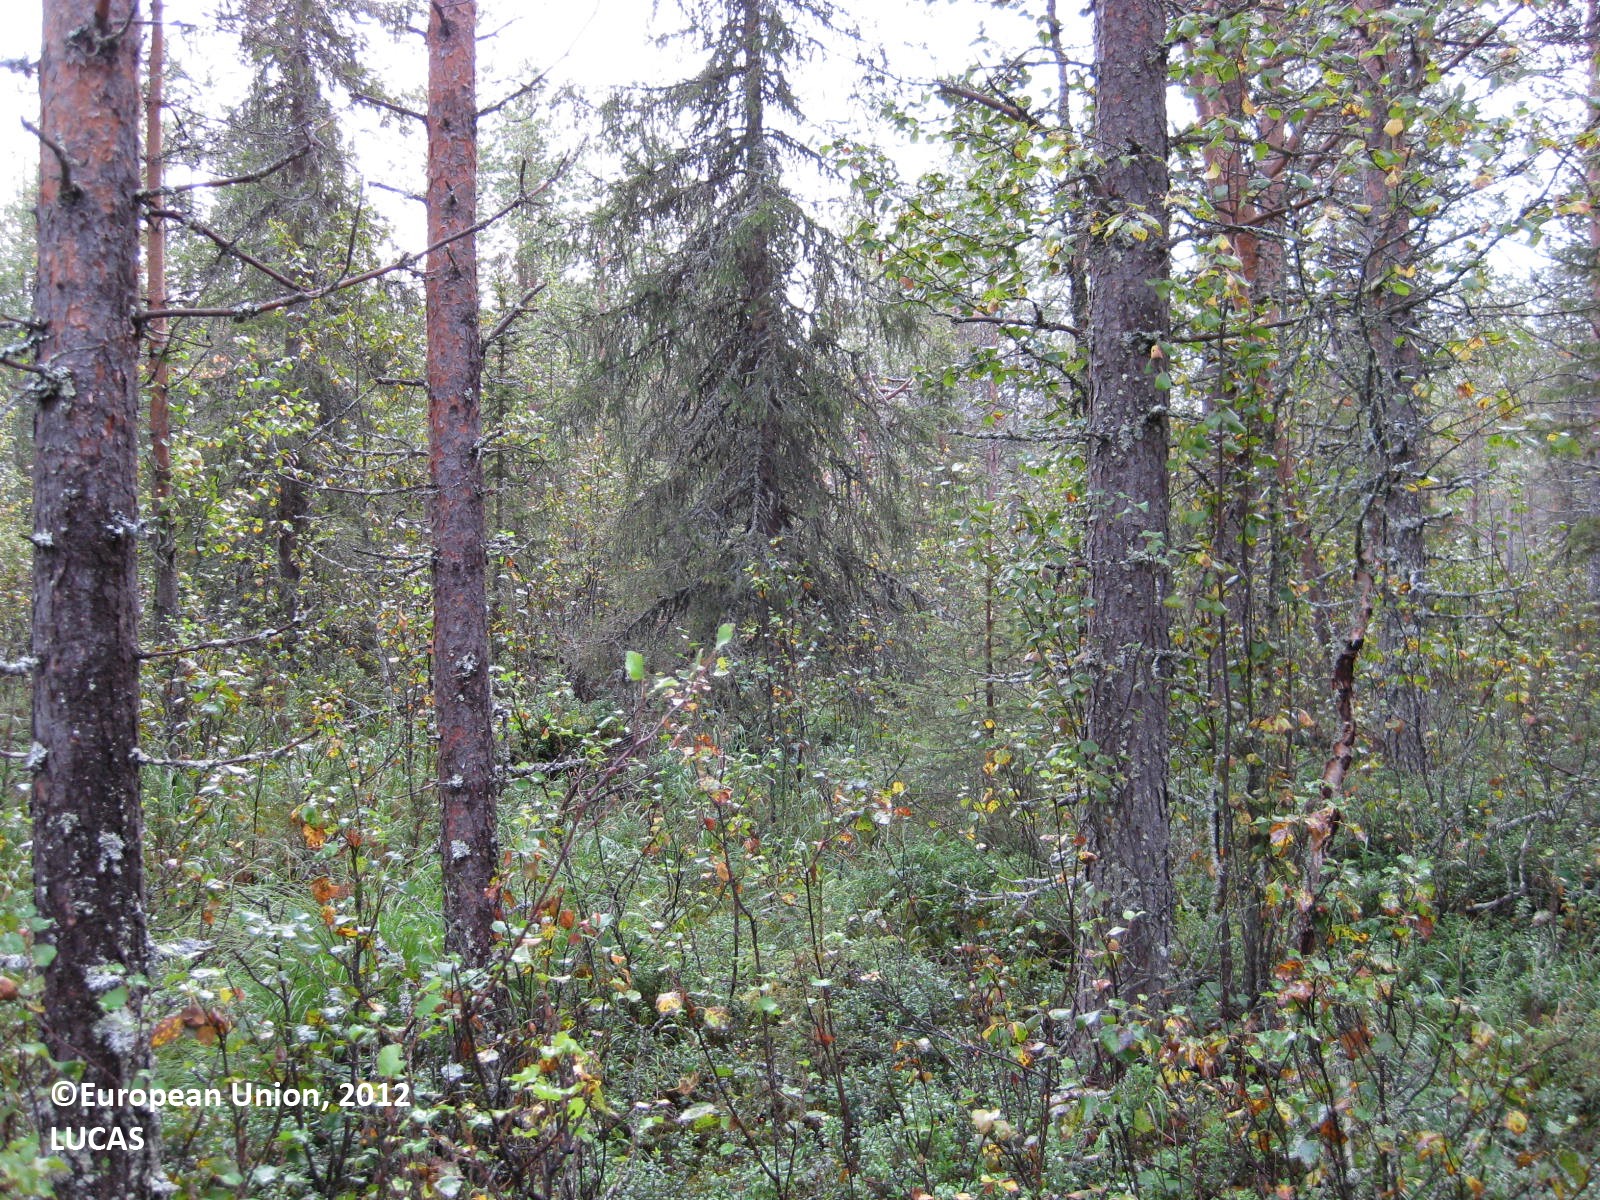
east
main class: Woodland
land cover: Pine dominated mixed woodland
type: boreal forest
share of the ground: 50 - 75 %
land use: Forestry
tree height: > 5 m
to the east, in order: Pine dominated mixed woodland; Ditches and canals; Pine dominated mixed woodland; Ditches and canals; Pine dominated coniferous woodland; Ditches and canals; Pine dominated coniferous woodland
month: August
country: FI
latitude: 66.0792
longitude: 28.8405
